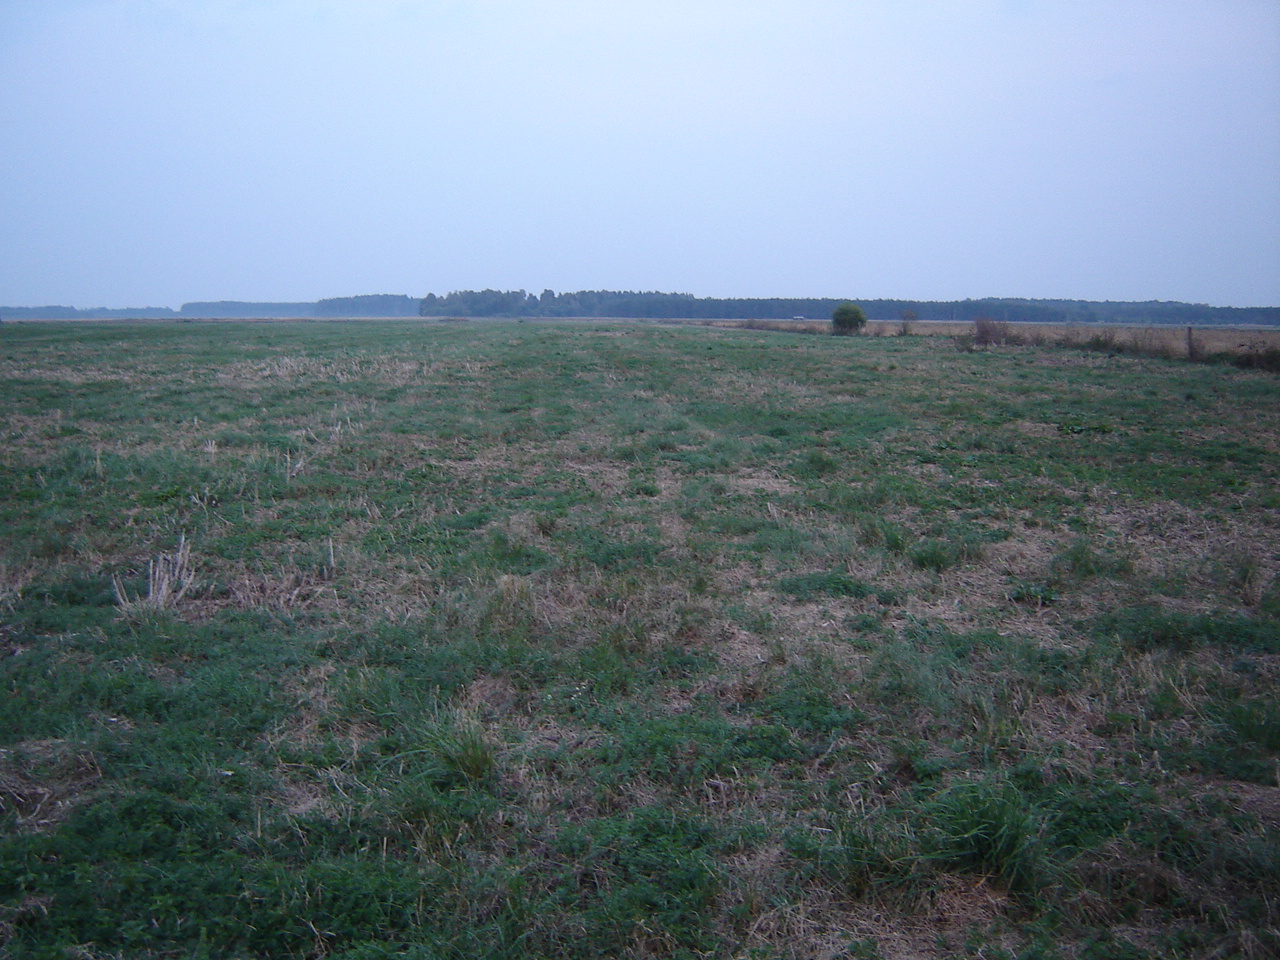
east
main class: Grassland
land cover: Grassland without tree/shrub cover
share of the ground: > 75 %
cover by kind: herbaceous plants 100 %
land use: Agriculture (excluding fallow land and kitchen gardens)
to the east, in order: Grassland without tree/shrub cover
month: September
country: LT
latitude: 54.4218
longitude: 24.8293
